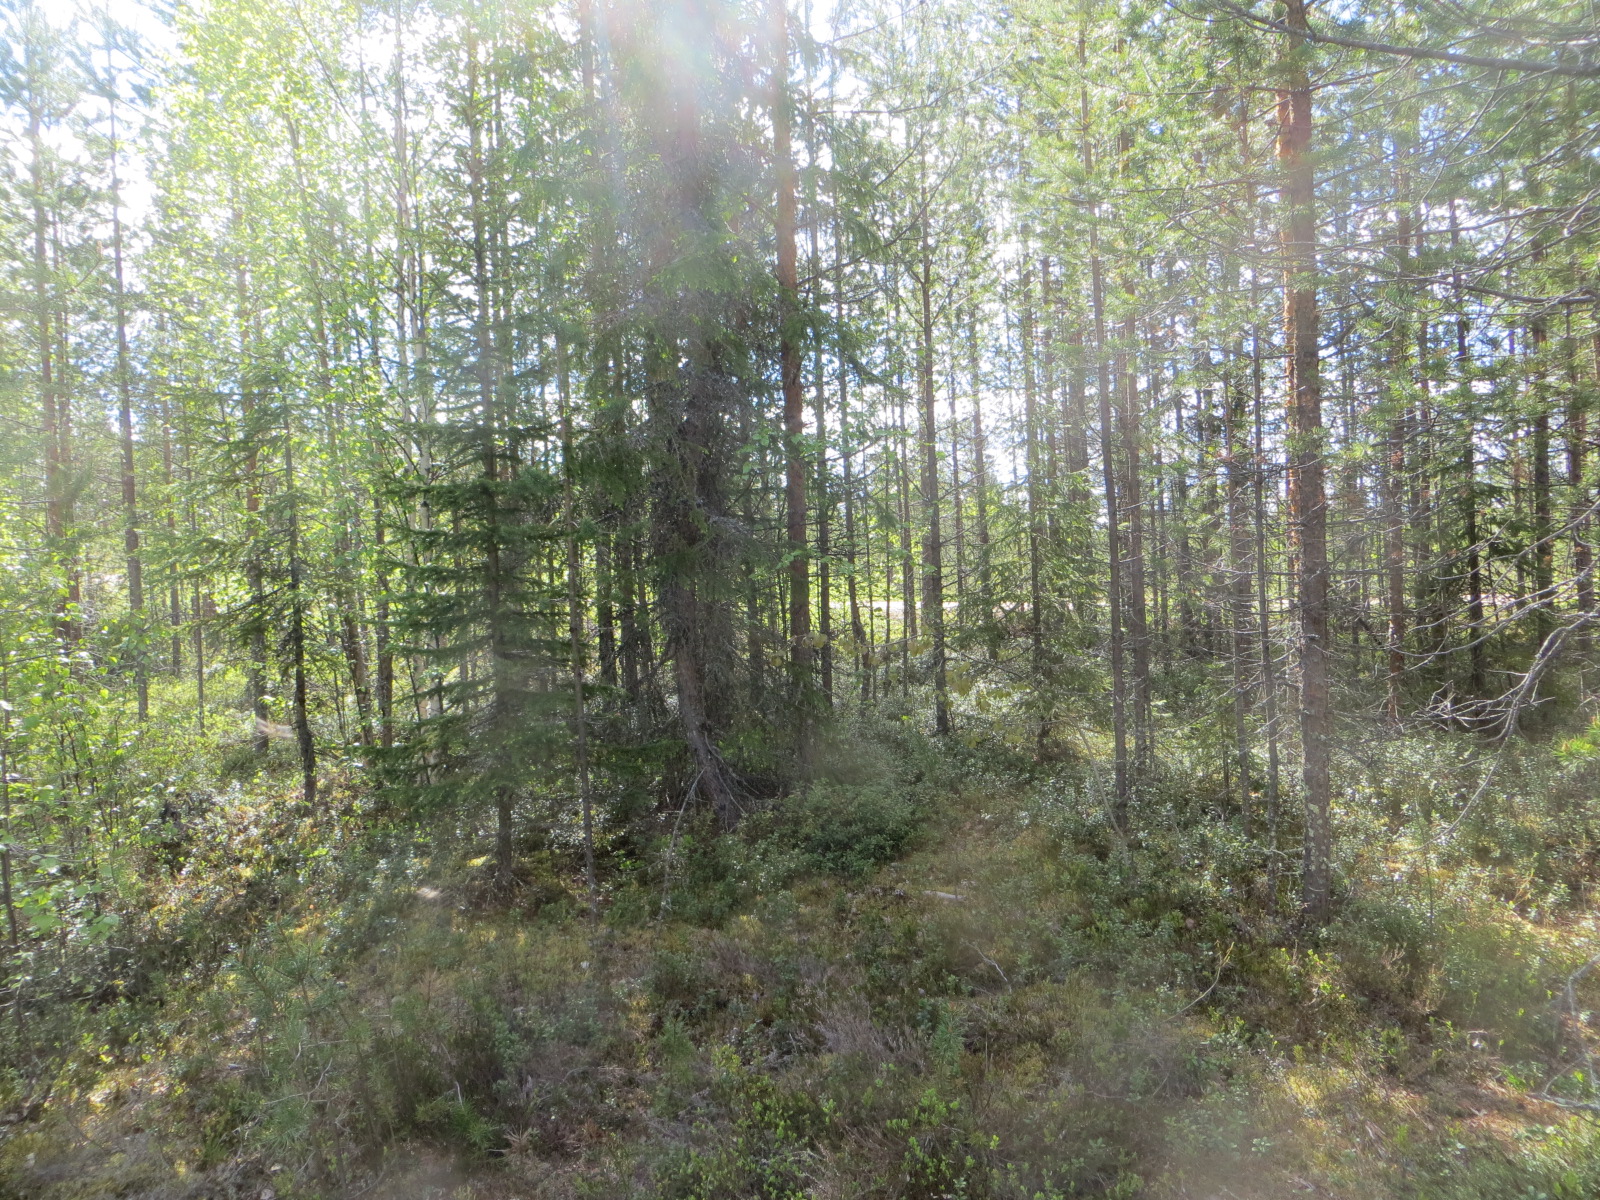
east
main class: Woodland
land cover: Other mixed woodland
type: boreal forest
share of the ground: > 75 %
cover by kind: coniferous forest trees 50 %, broadleaved forest trees 30 %, shrubs 20 %
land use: Forestry
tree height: > 5 m
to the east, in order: Other mixed woodland; Pine dominated coniferous woodland; Ditches and canals; Paved roads, cycling and walking lanes; Ditches and canals; Pine dominated coniferous woodland; Other mixed woodland; Broadleaved woodland; Pine dominated coniferous woodland
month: June
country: FI
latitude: 66.9170
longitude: 25.3925
